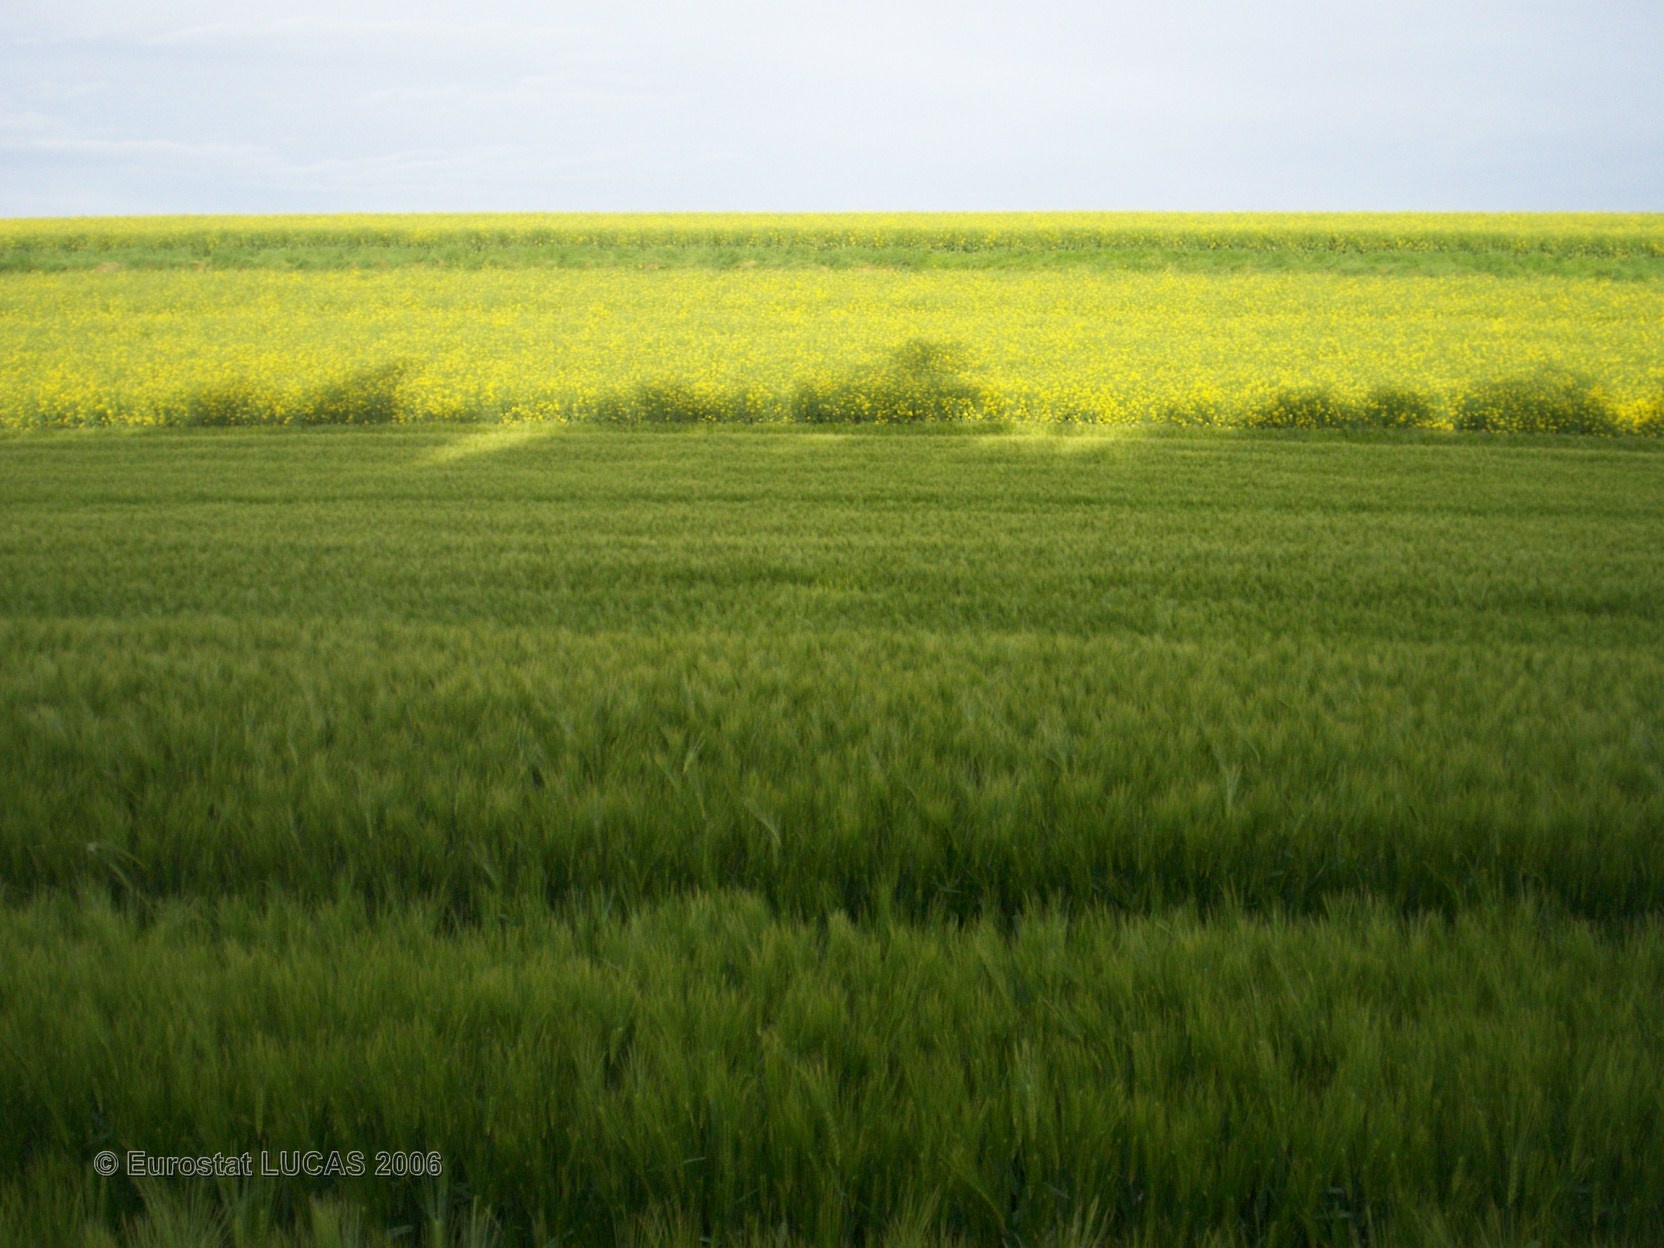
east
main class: Cropland
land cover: Barley
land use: Agriculture (excluding fallow land and kitchen gardens)
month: May
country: FR
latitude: 49.4688
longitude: 4.3797
